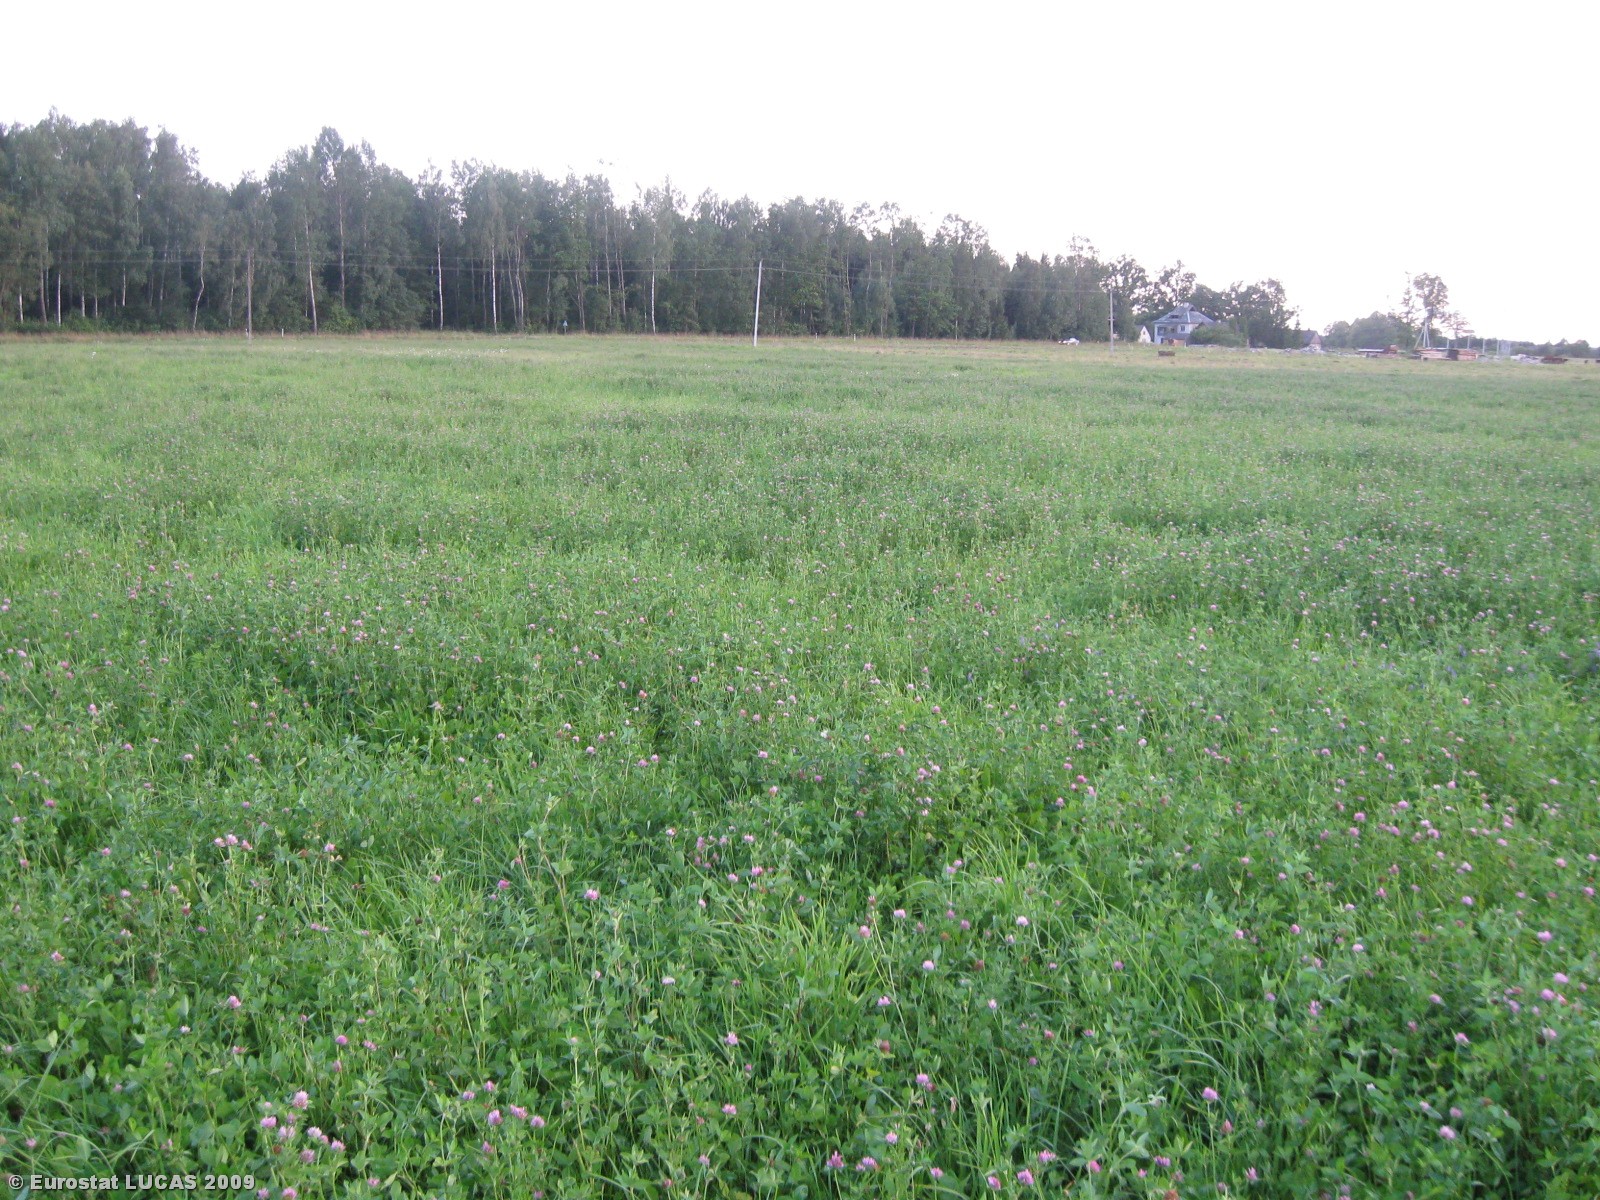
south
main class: Cropland
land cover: Clovers
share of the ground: > 75 %
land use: Agriculture (excluding fallow land and kitchen gardens)
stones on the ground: < 10 %
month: July
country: LT
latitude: 55.2649
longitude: 22.6699
